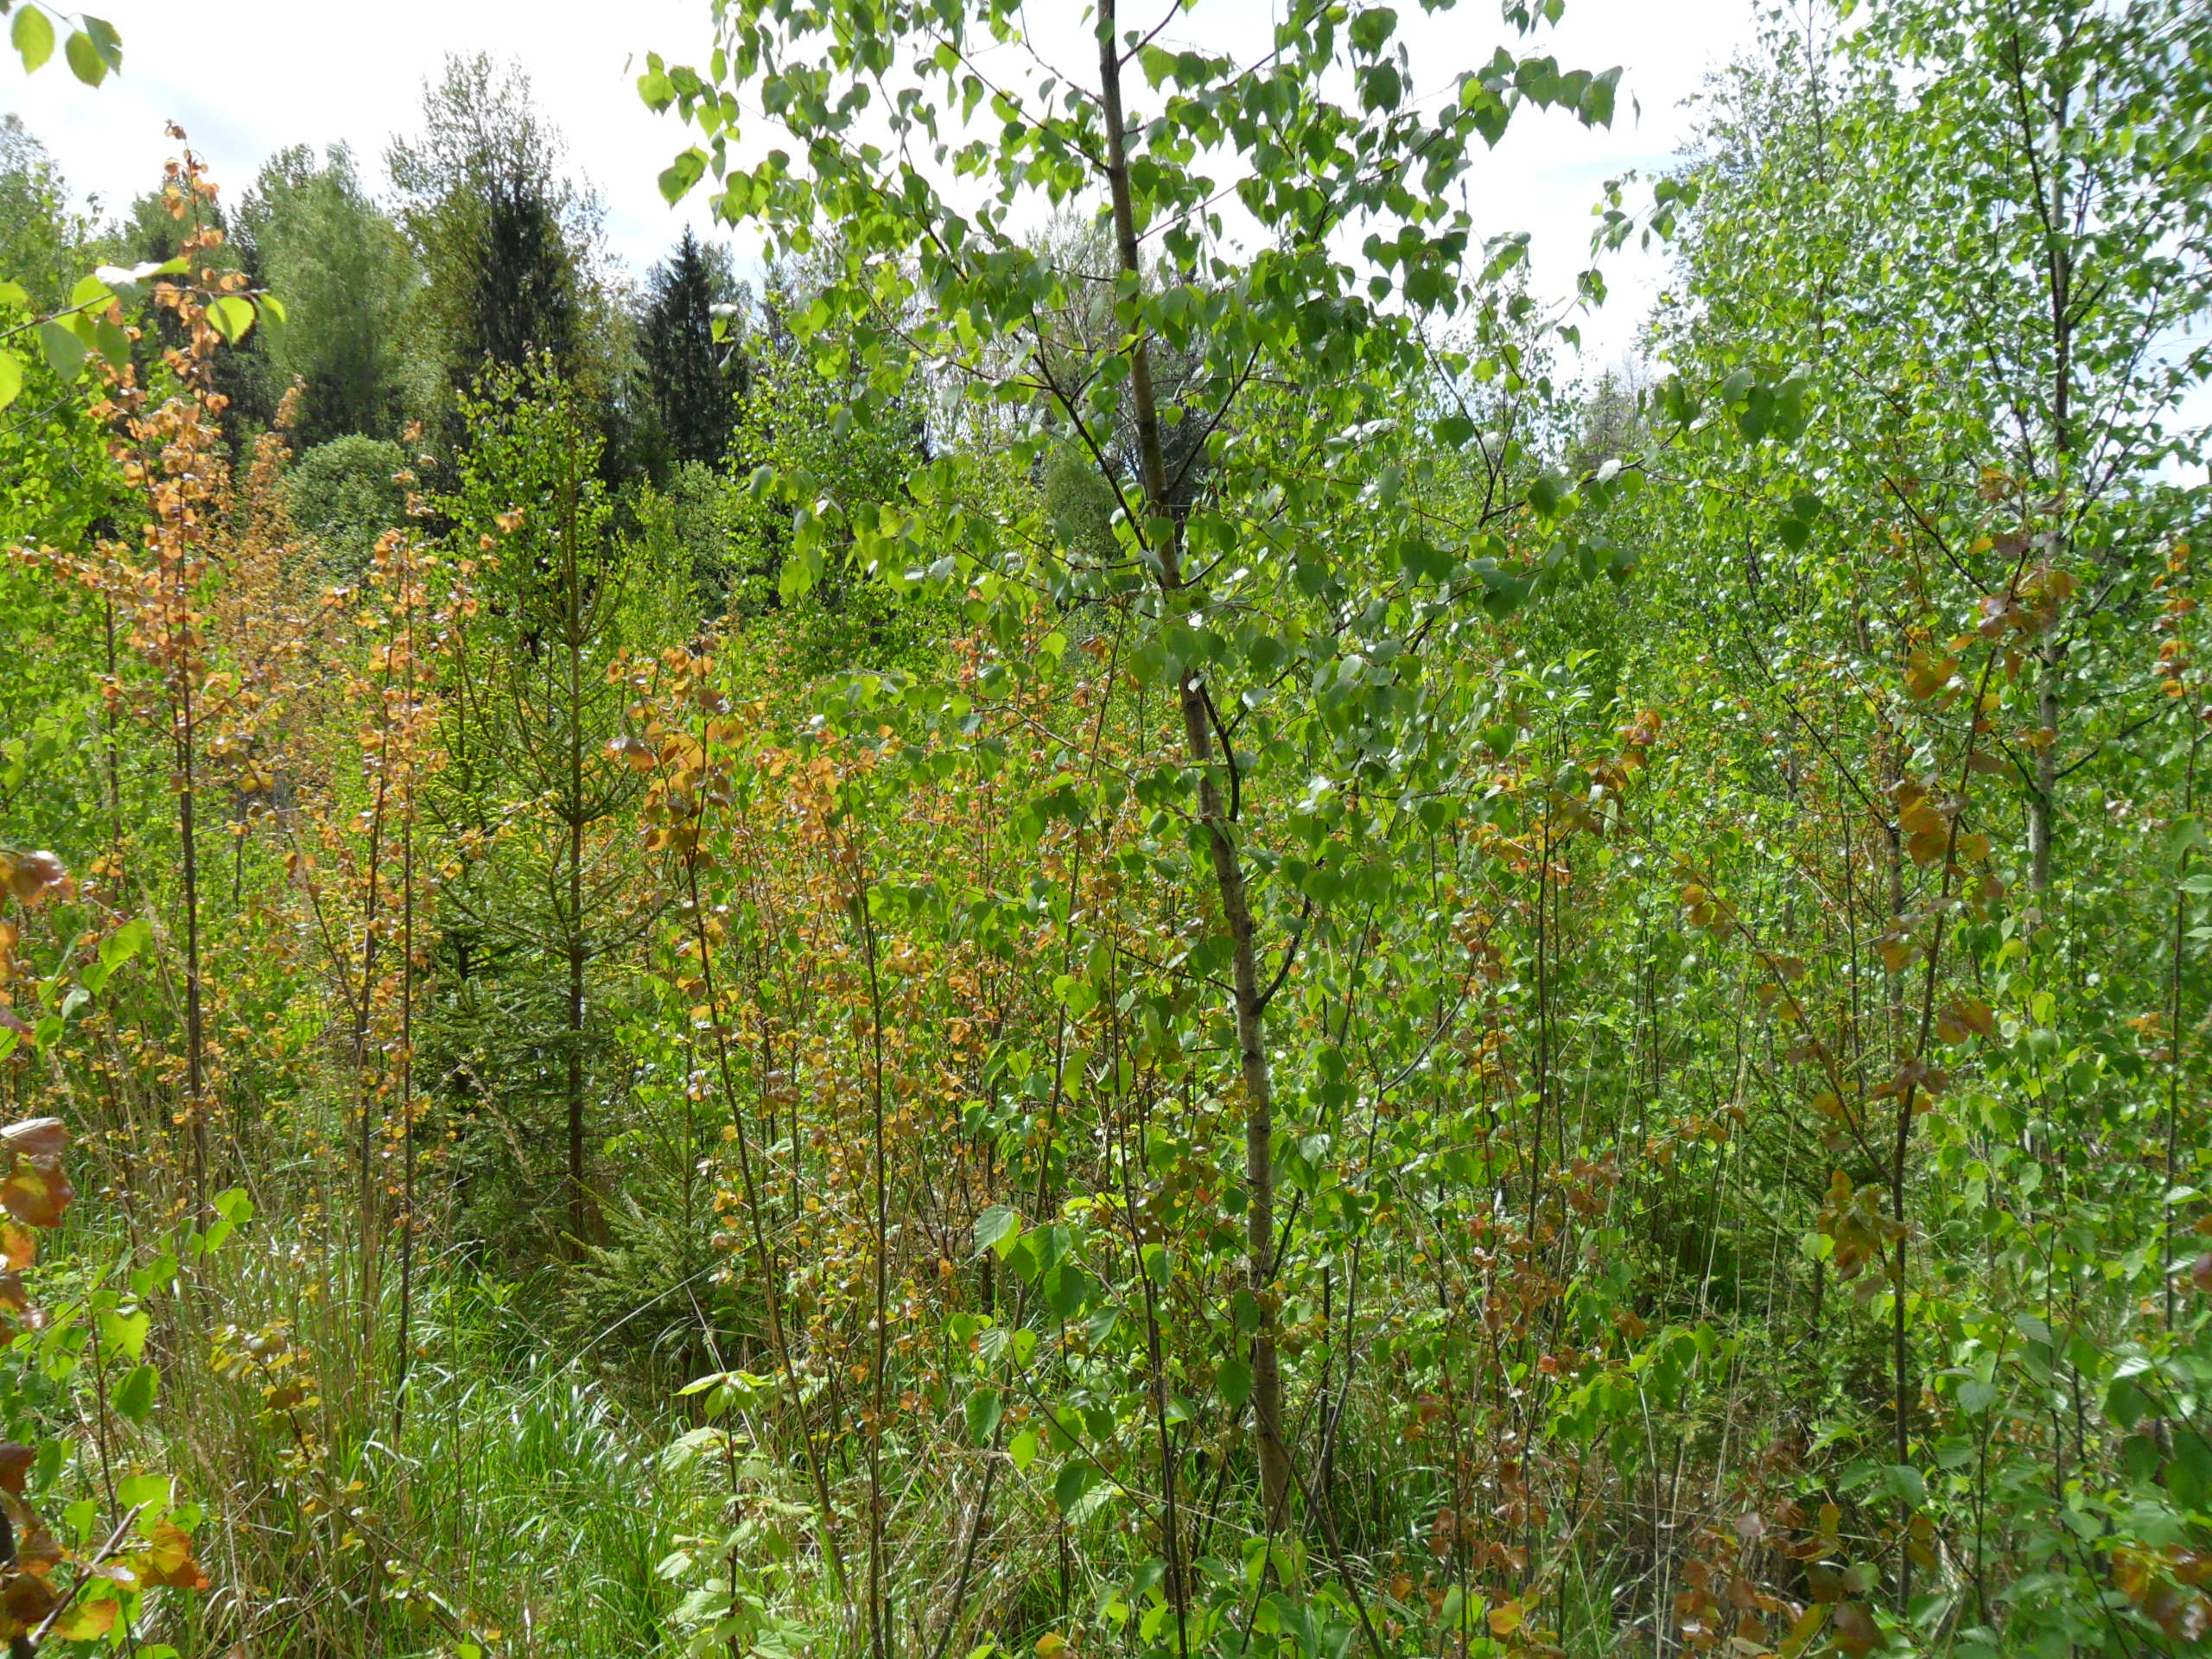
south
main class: Woodland
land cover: Broadleaved woodland
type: non-riverine alder, birch or aspen forest
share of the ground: > 75 %
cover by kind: broadleaved forest trees 80 %, coniferous forest trees 20 %
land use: Forestry
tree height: < 5 m
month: May
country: LV
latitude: 57.2916
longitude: 22.4477
